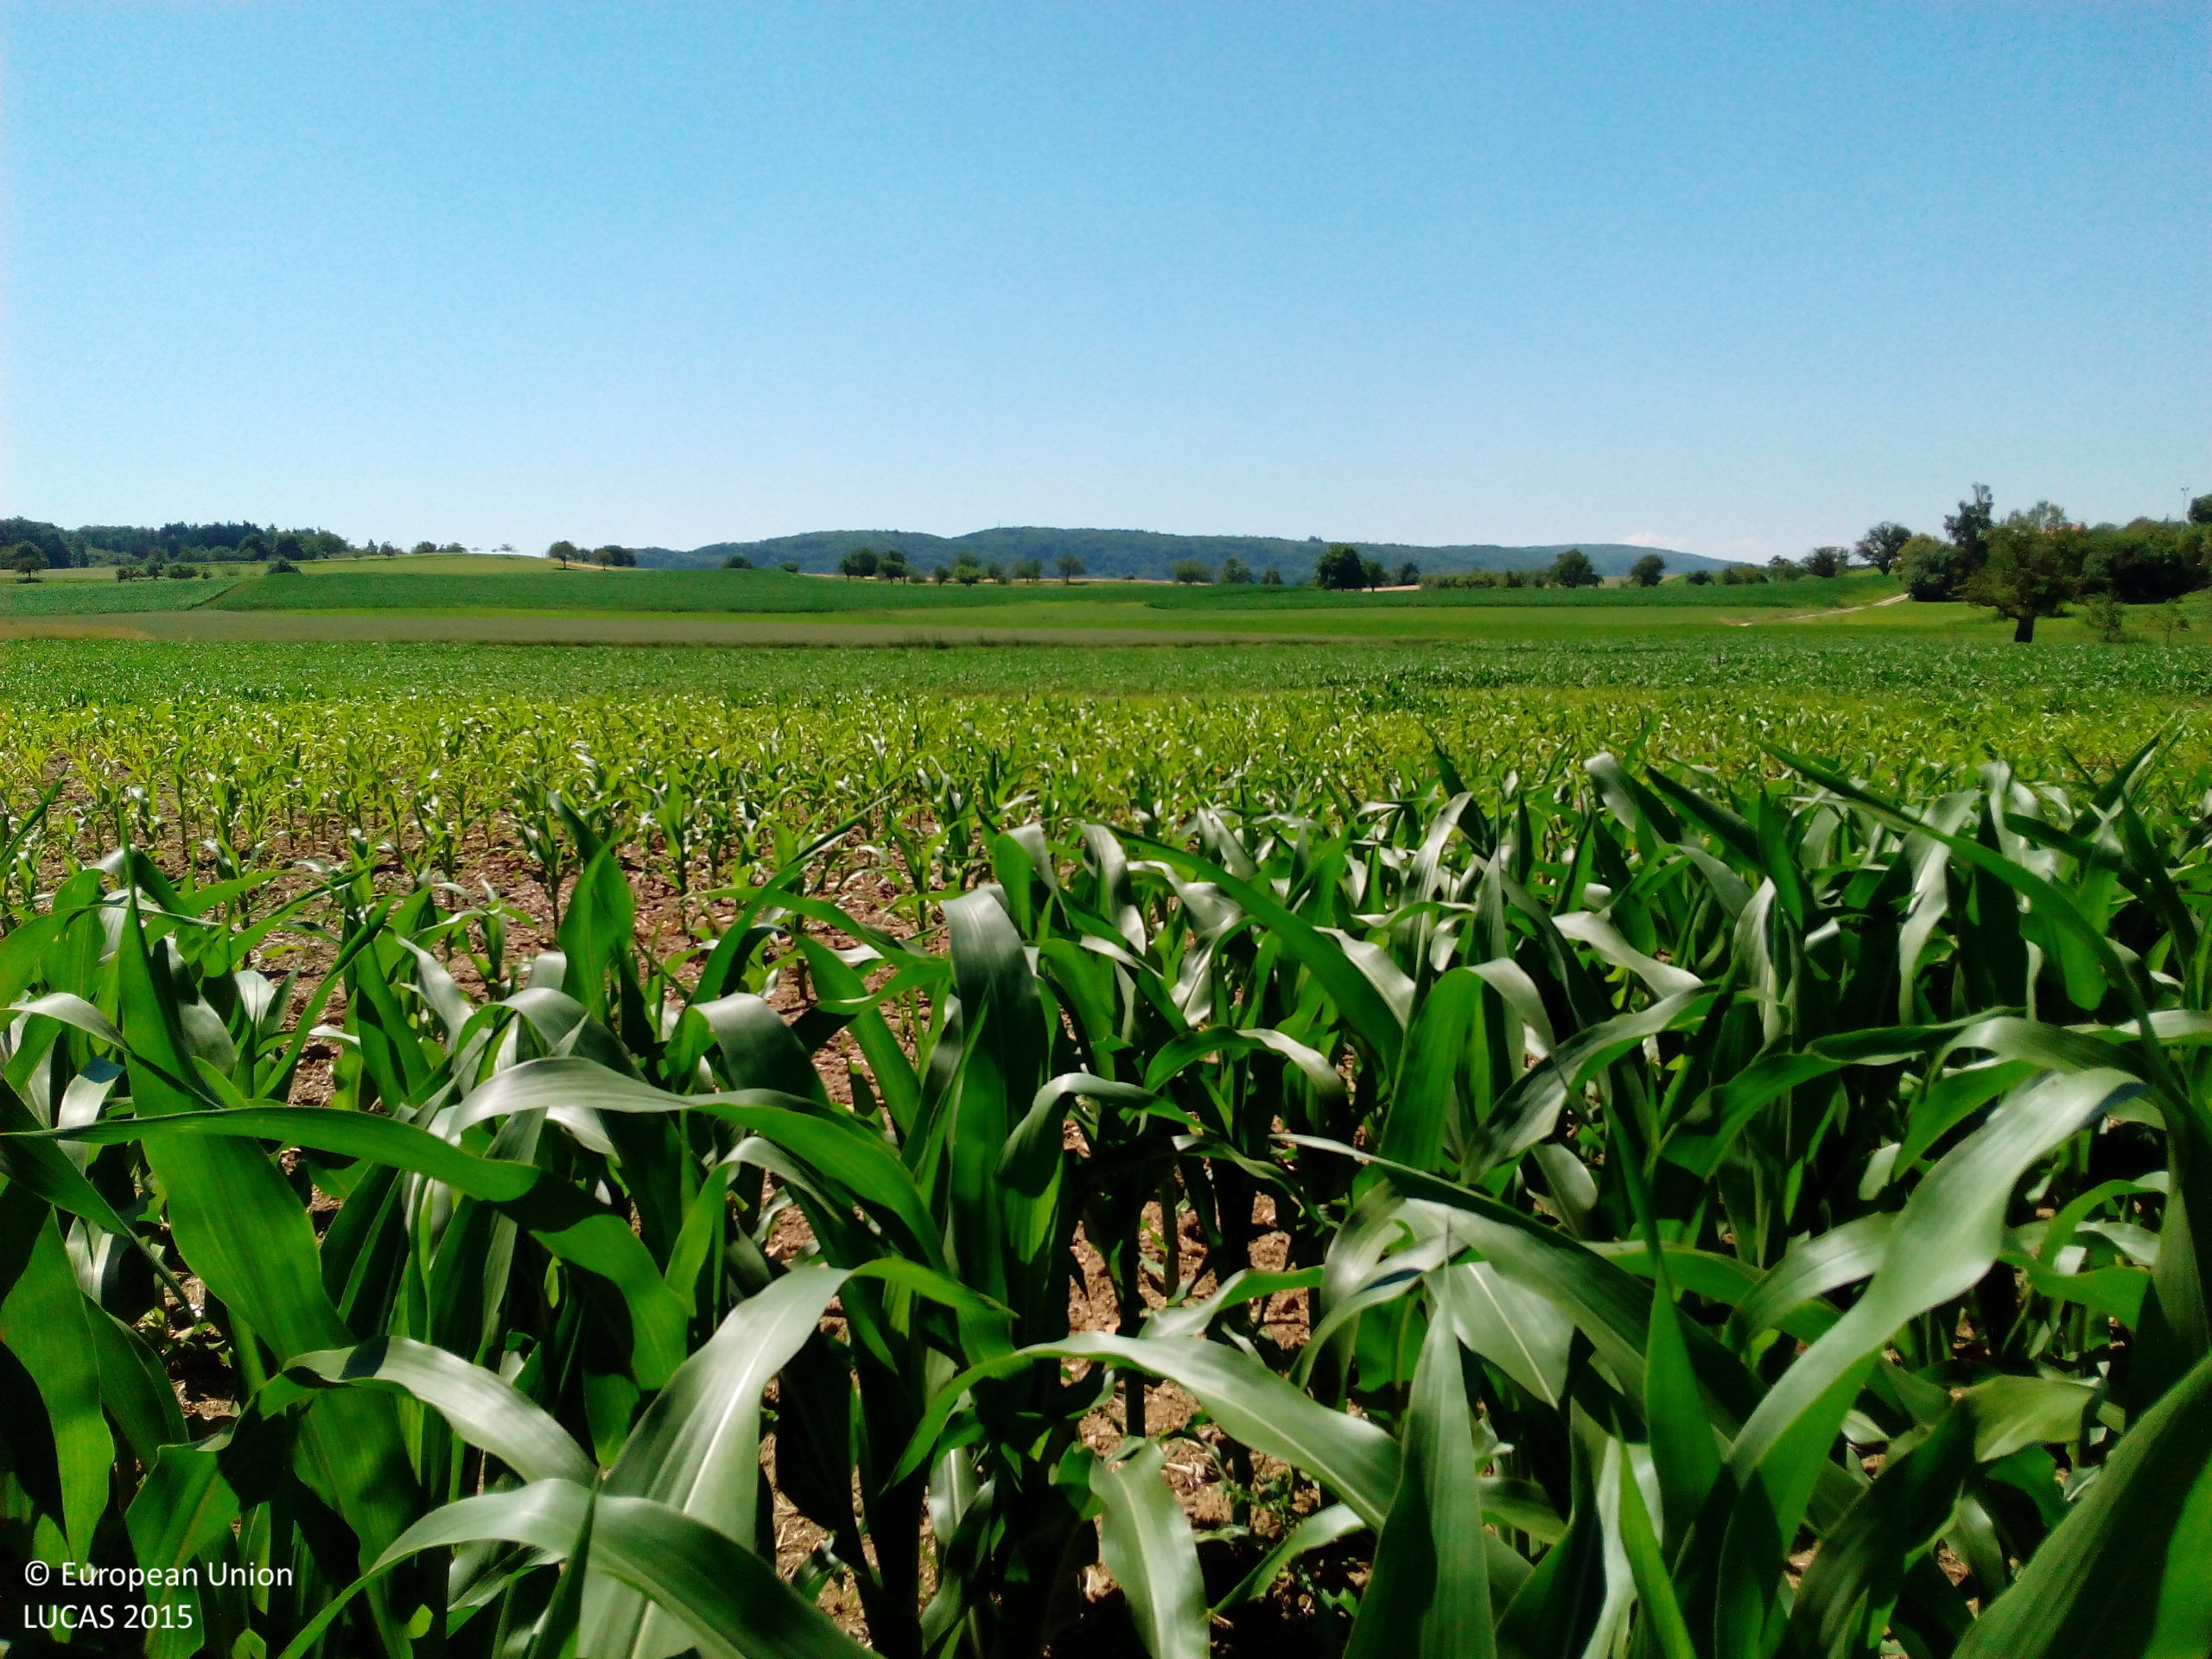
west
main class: Cropland
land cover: Maize
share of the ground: > 75 %
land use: Agriculture (excluding fallow land and kitchen gardens)
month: July
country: DE
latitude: 47.7660
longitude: 8.7067
